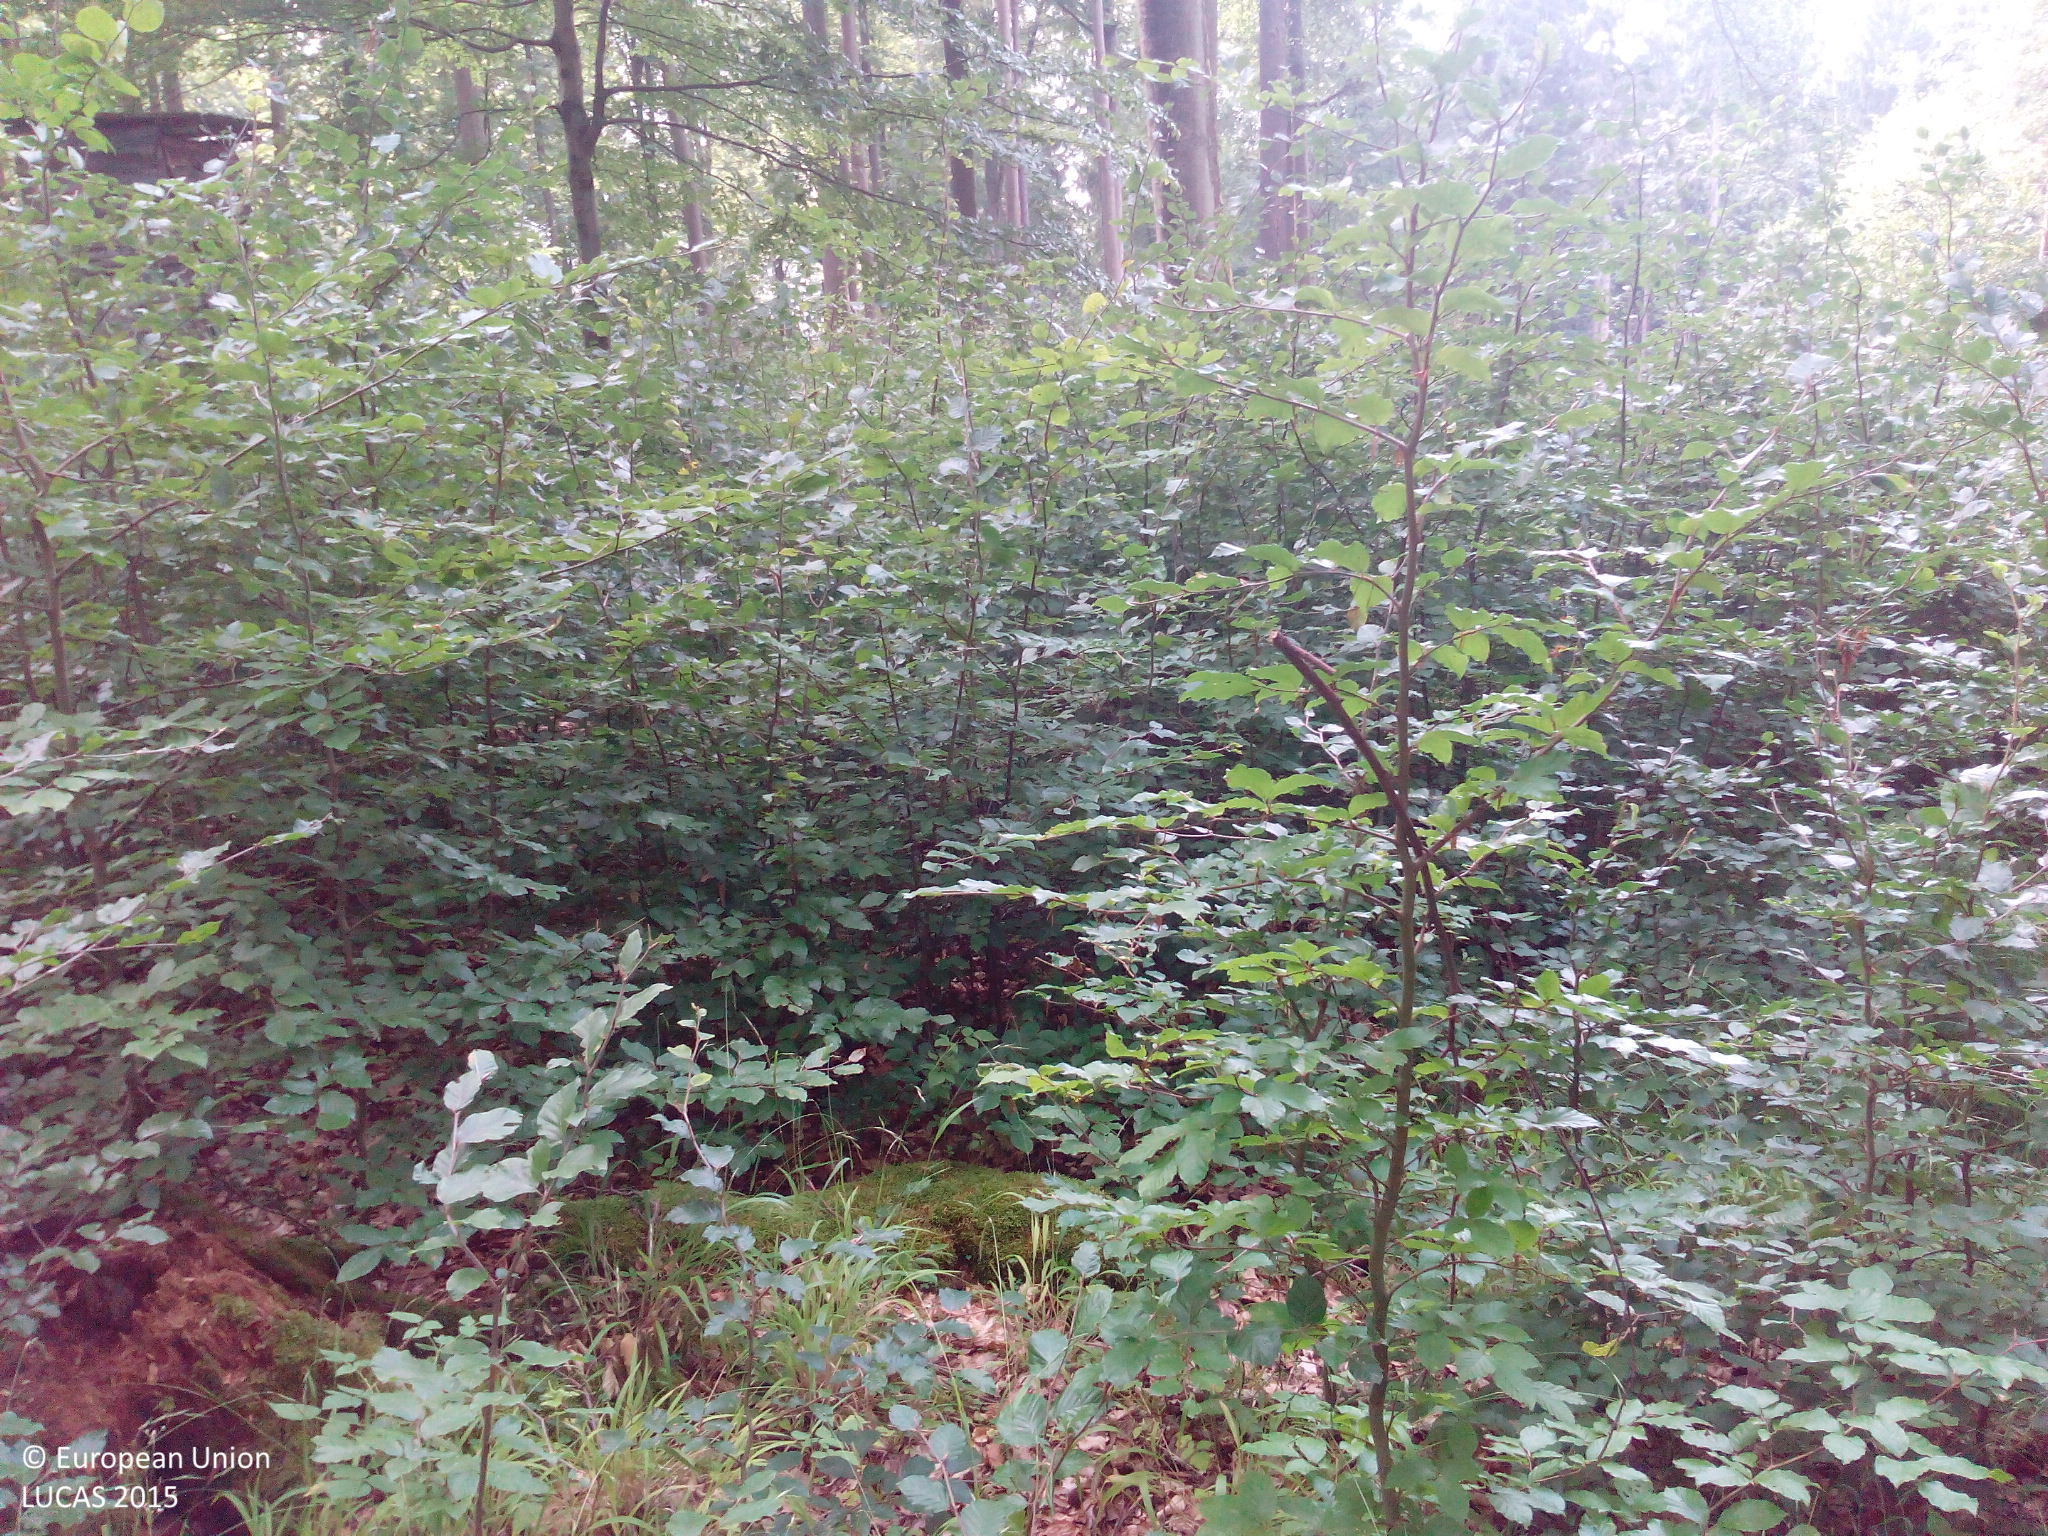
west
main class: Woodland
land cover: Broadleaved woodland
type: beech forest
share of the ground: > 75 %
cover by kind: broadleaved forest trees 70 %, coniferous forest trees 10 %, shrubs 10 %, herbaceous plants 10 %
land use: Forestry
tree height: > 5 m
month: August
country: DE
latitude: 50.2764
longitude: 8.1061
